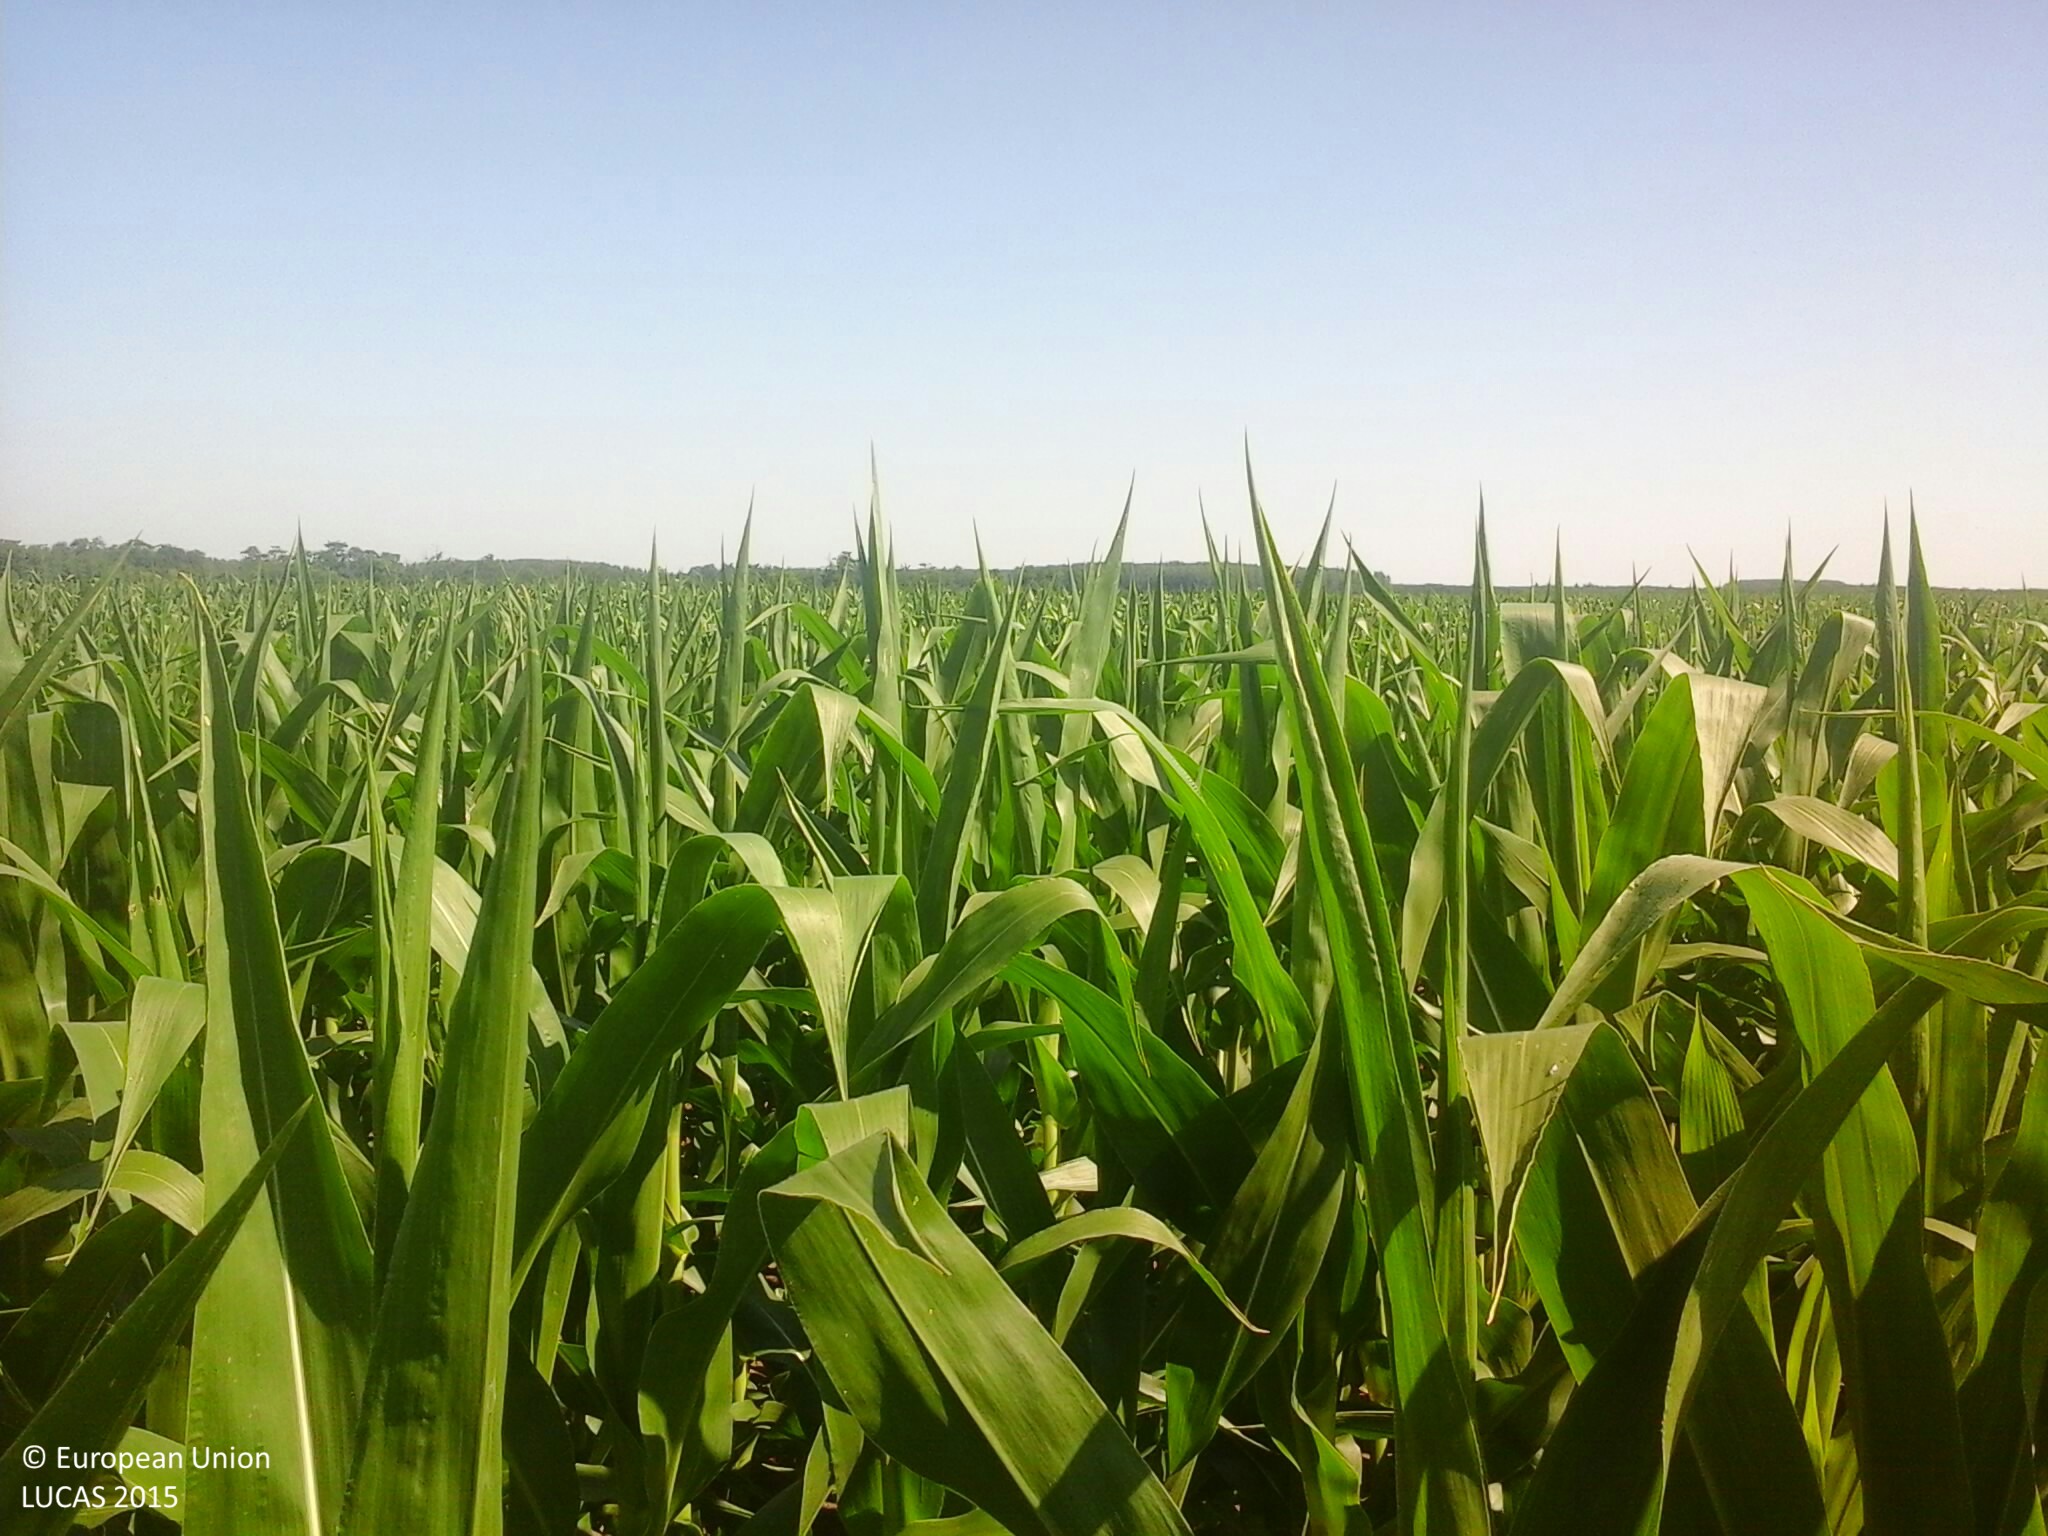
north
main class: Cropland
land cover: Maize
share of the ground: 50 - 75 %
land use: Agriculture (excluding fallow land and kitchen gardens)
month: July
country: HU
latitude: 47.8607
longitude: 21.9606
